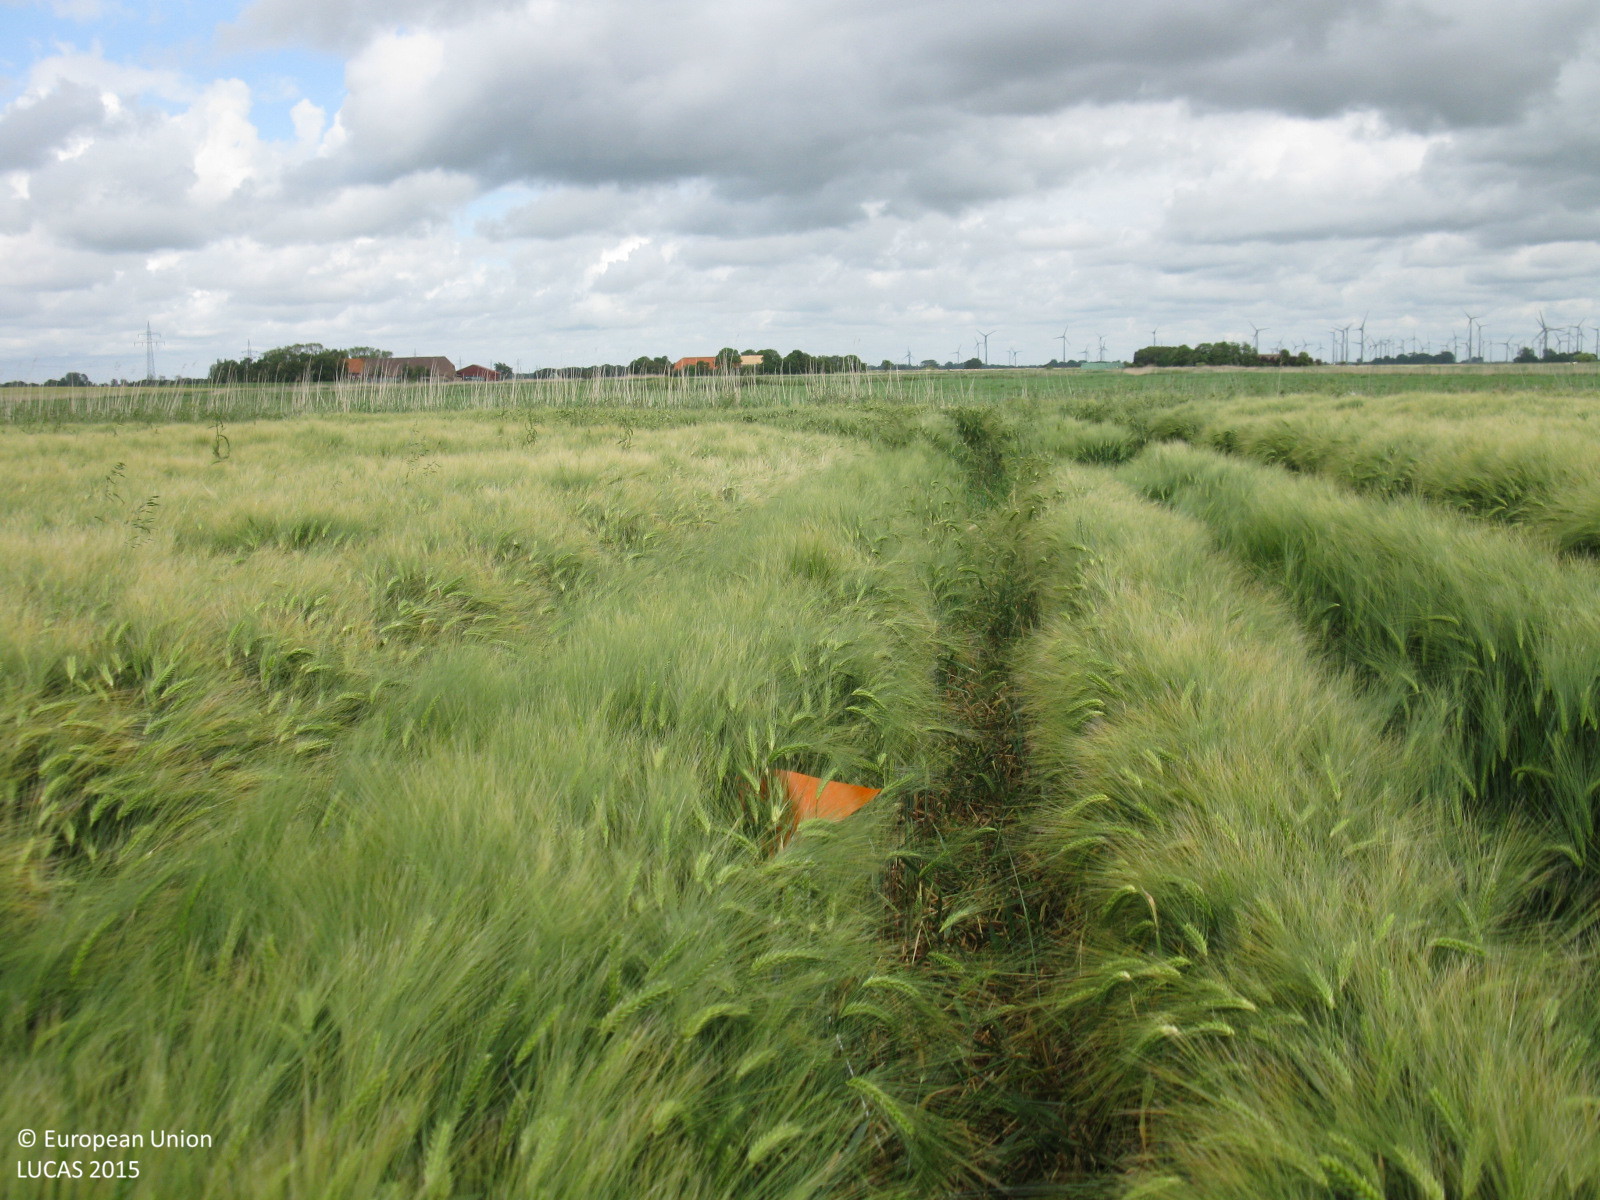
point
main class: Cropland
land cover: Barley
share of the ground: > 75 %
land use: Agriculture (excluding fallow land and kitchen gardens)
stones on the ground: < 10 %
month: June
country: DE
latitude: 53.6428
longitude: 7.3536
